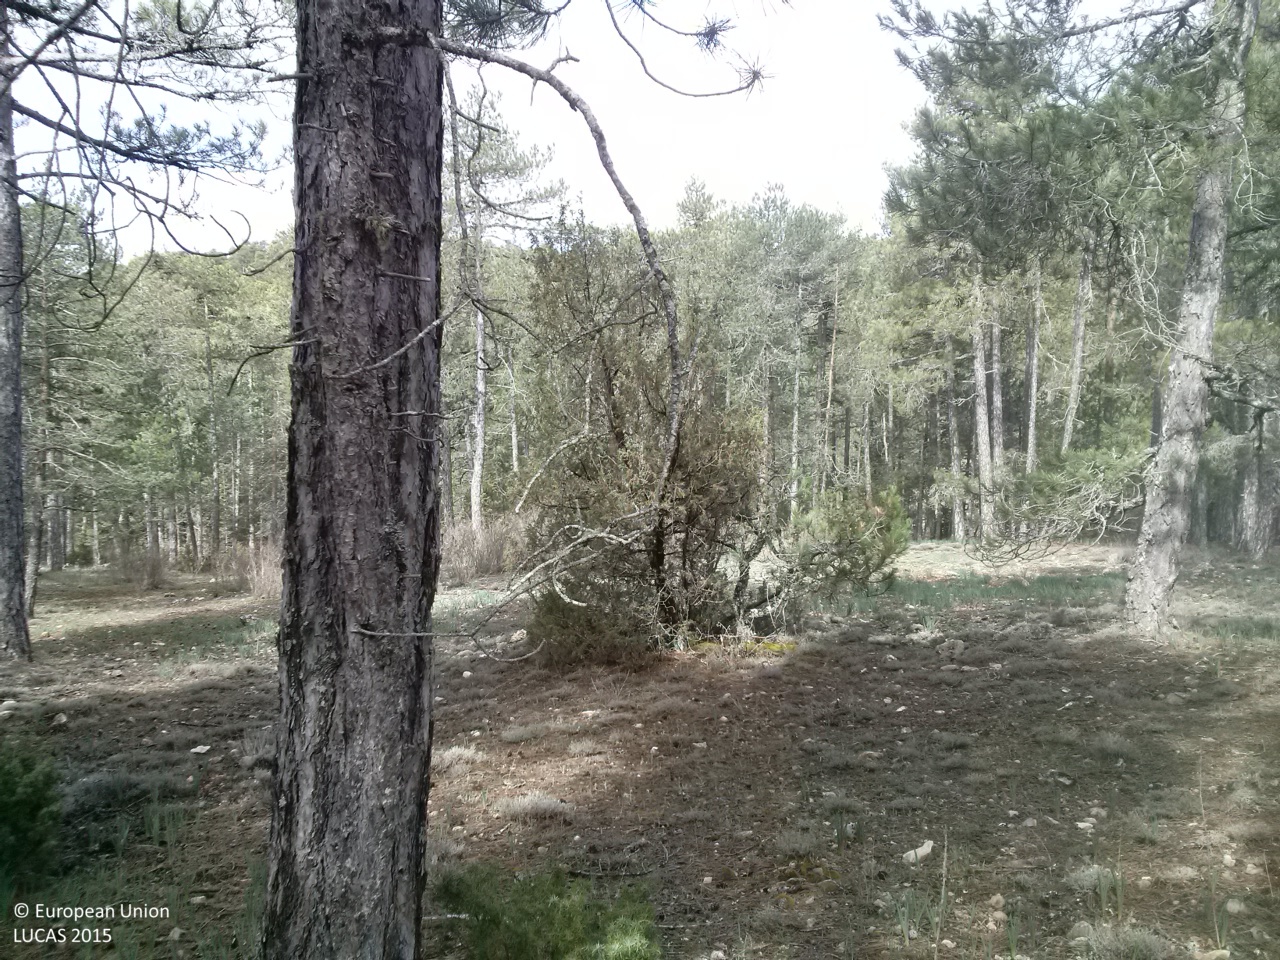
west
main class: Woodland
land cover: Pine dominated coniferous woodland
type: coniferous forest of the mediterranean region
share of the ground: 50 - 75 %
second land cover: Grassland without tree/shrub cover
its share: 10 - 25 %
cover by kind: coniferous forest trees 70 %, herbaceous plants 25 %, consolidated bare surface 5 %
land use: Forestry
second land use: Agriculture (excluding fallow land and kitchen gardens)
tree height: > 5 m
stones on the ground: 10 - 25 %
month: April
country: ES
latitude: 40.2525
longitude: -1.9018
